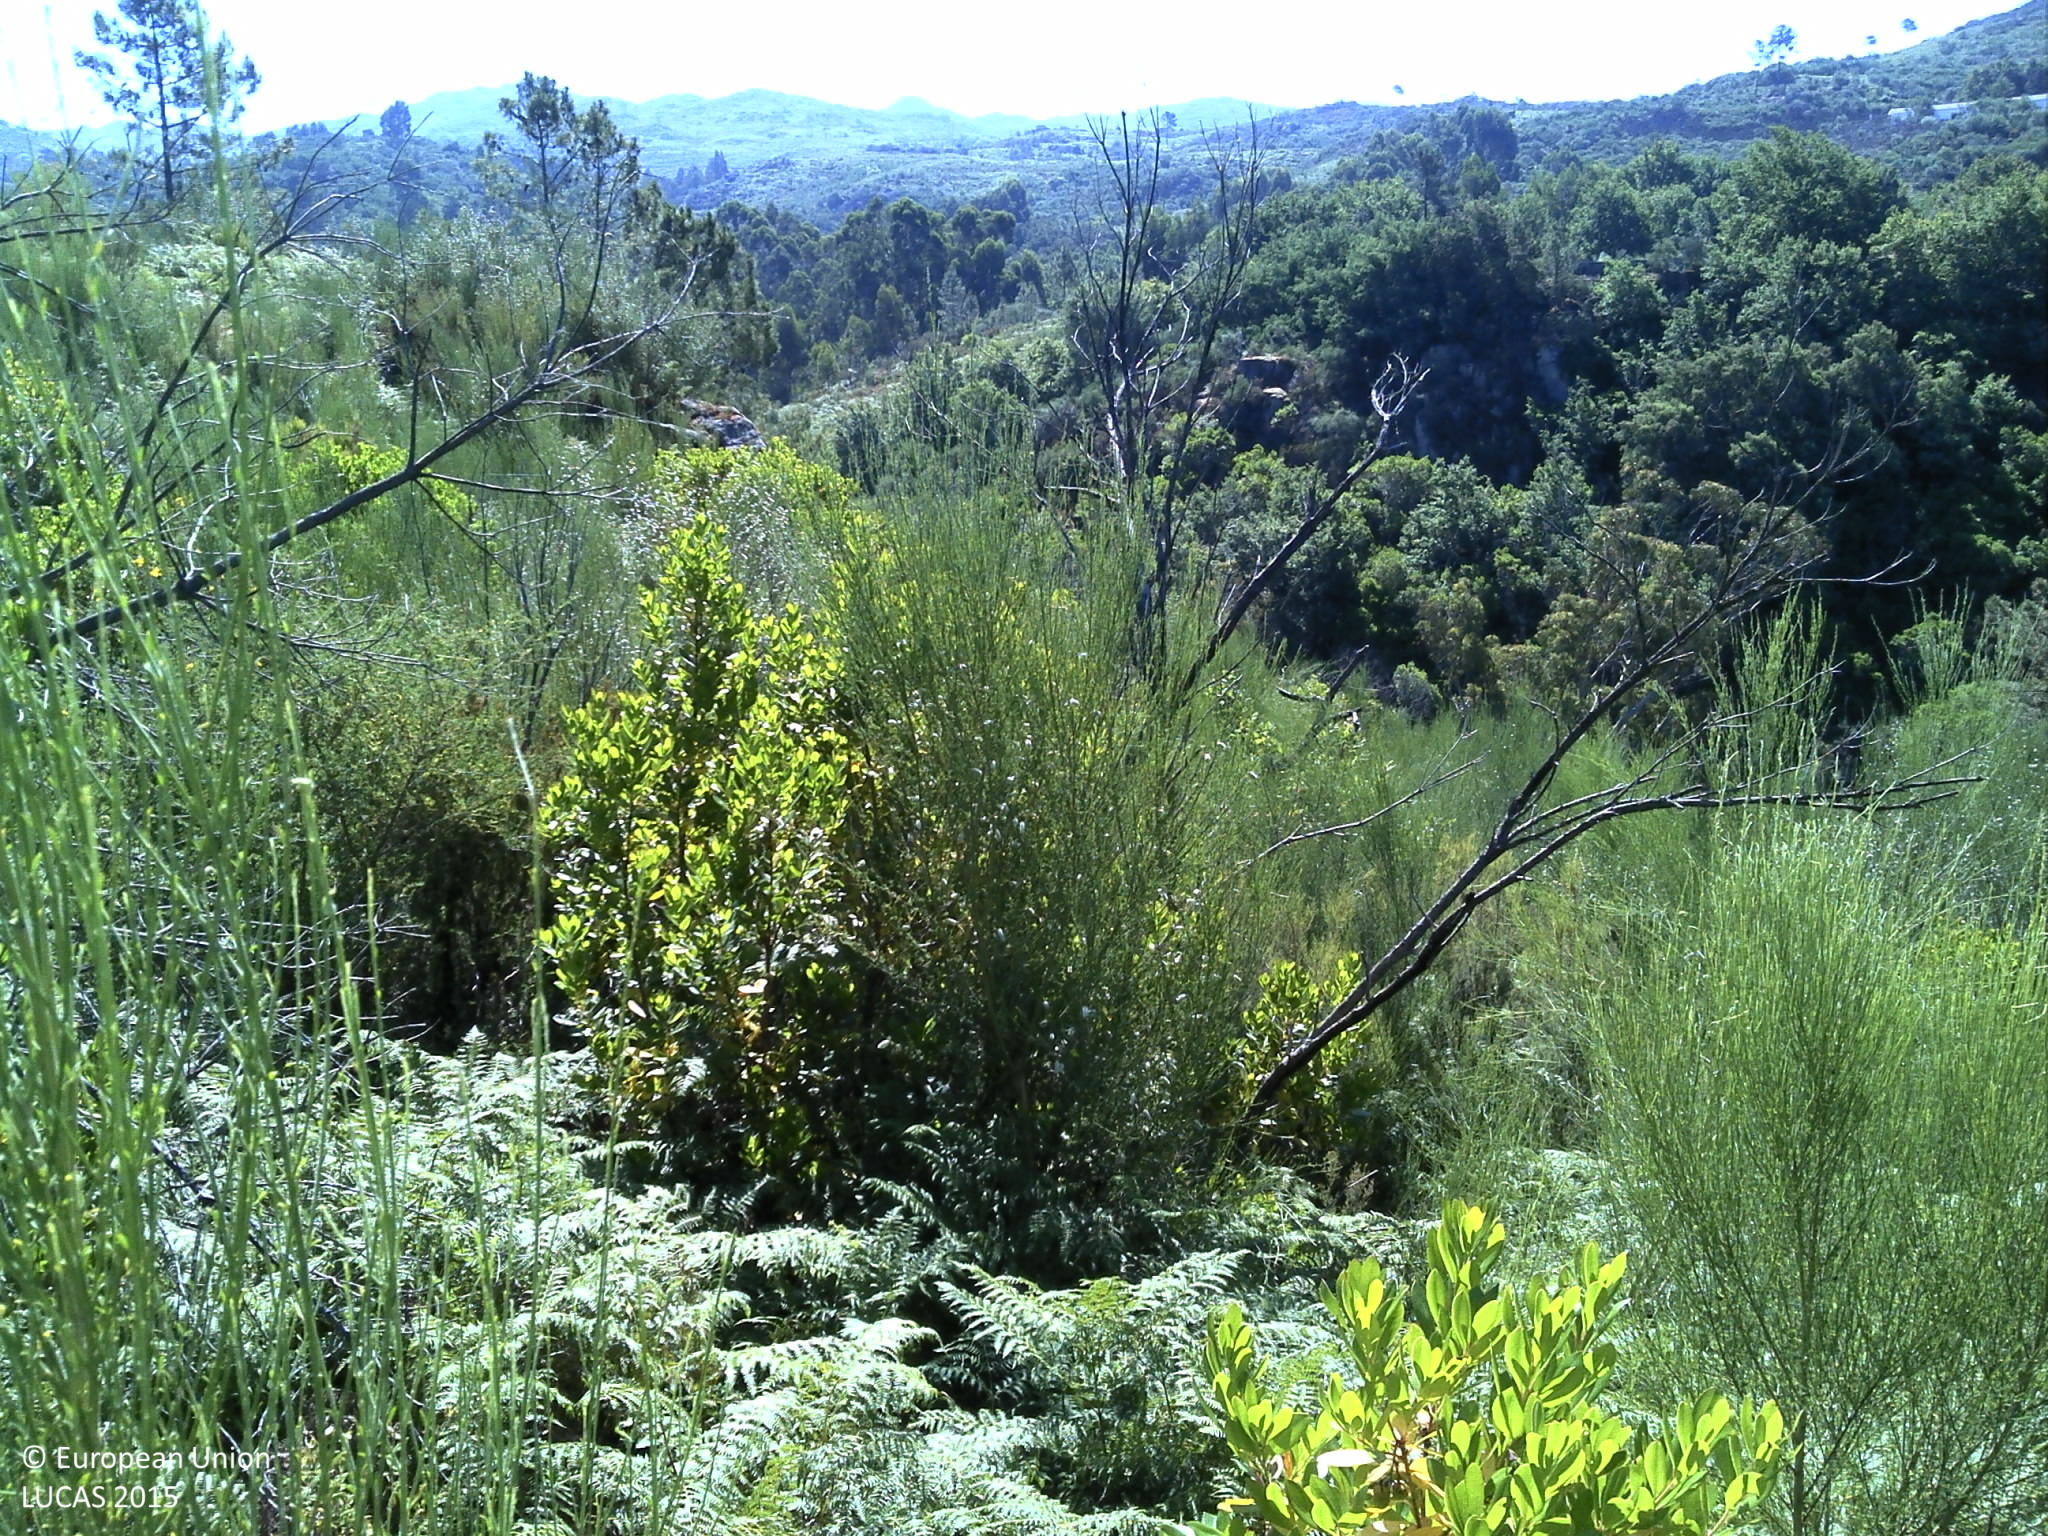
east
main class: Shrubland
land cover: Shrubland without tree cover
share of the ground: > 75 %
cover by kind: shrubs 75 %, herbaceous plants 10 %, consolidated bare surface 10 %, unconsolidated bare surface 5 %
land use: Semi-natural and natural areas not in use
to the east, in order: Shrubland without tree cover; Rock outcrops; Shrubland with sparse tree cover; Broadleaved woodland; Rivers and streams; Broadleaved woodland; Shrubland with sparse tree cover
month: June
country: PT
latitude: 41.8419
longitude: -8.2790
